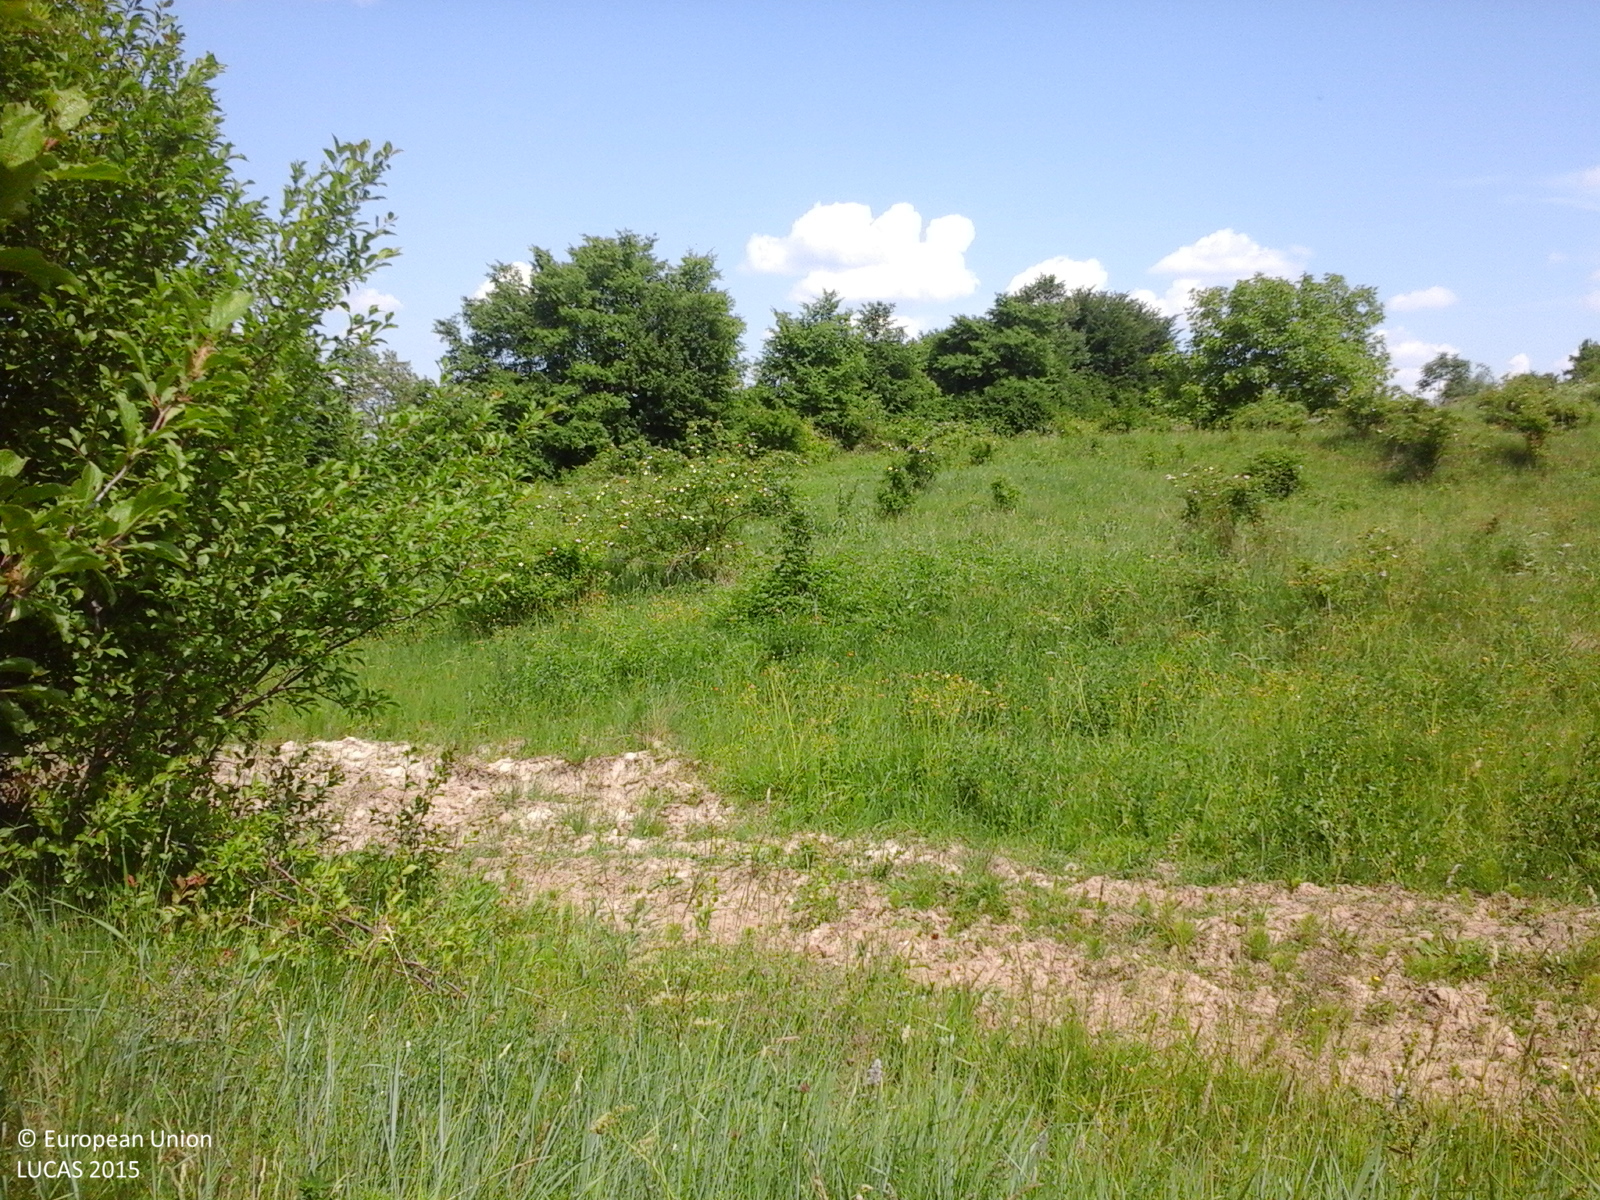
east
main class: Cropland
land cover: Other fruit trees and berries
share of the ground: 50 - 75 %
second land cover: Grassland without tree/shrub cover
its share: 50 - 75 %
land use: Agriculture (excluding fallow land and kitchen gardens)
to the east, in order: Other fruit trees and berries; Grassland without tree/shrub cover; Tracks; Grassland with sparse tree/shrub cover; Tracks; Grassland with sparse tree/shrub cover; Shrubland with sparse tree cover; Maize; Other fresh vegetables; Vineyards; Fences; Vineyards; Arable land (only in case pi); Fences; Arable land (only in case pi); Permanent crops (only in case pi); Artificial constructions in urban areas
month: June
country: RO
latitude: 46.7804
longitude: 26.7646
